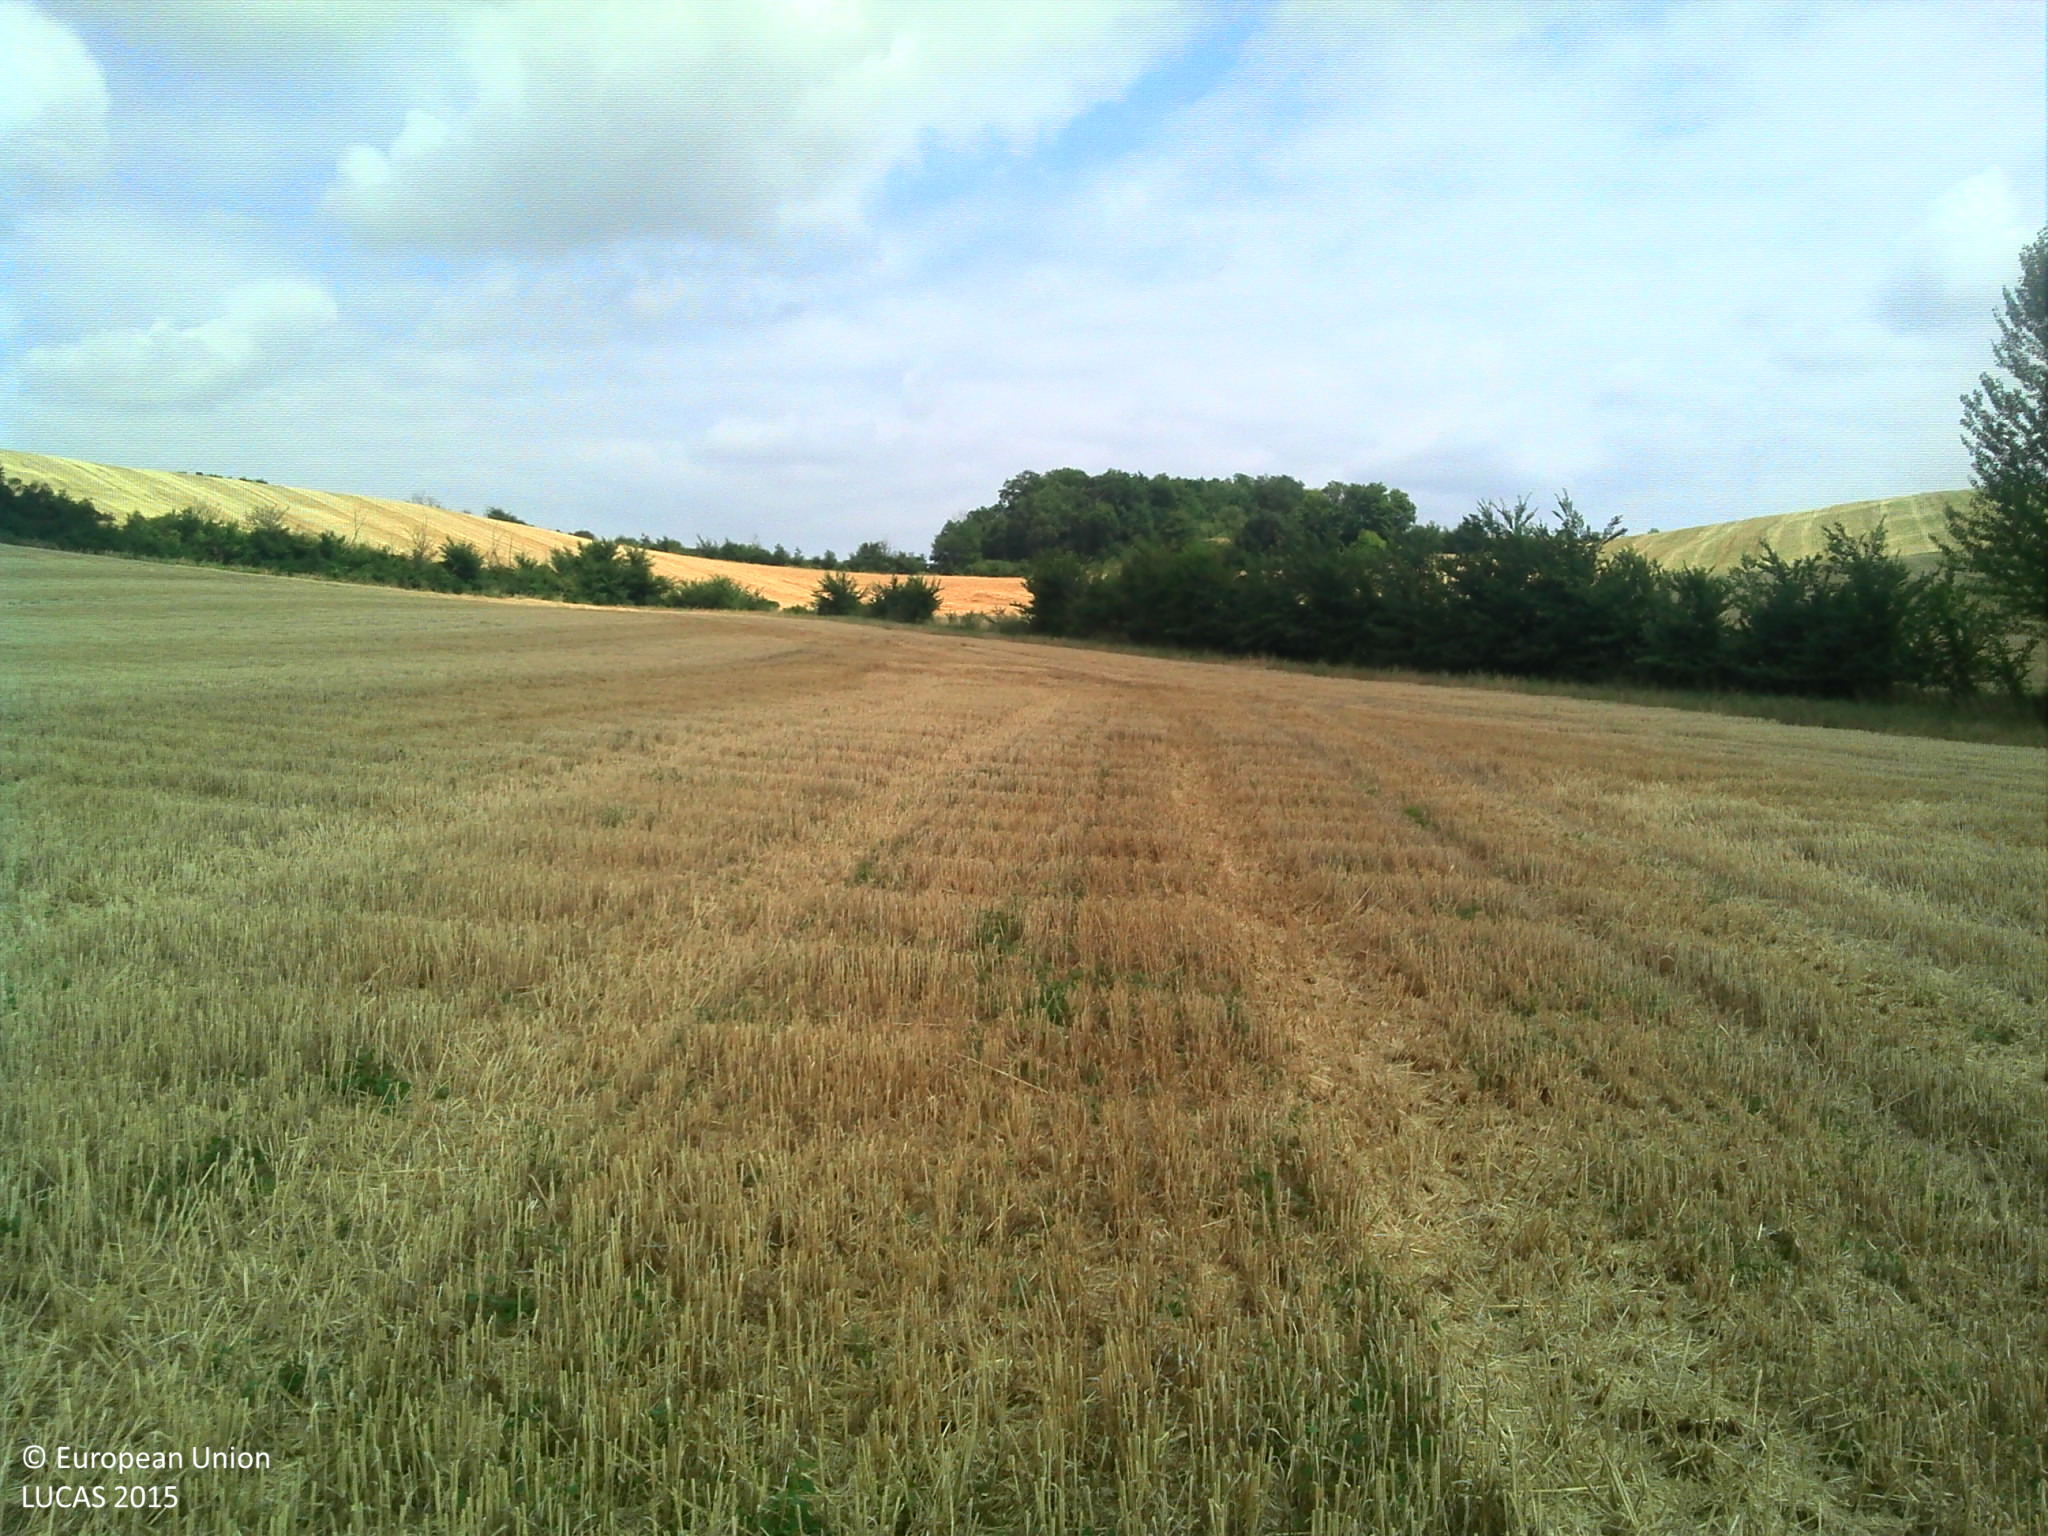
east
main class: Cropland
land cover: Barley
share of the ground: > 75 %
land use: Agriculture (excluding fallow land and kitchen gardens)
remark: Harvested field
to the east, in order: Barley; Grass margins; Ditches and canals; Managed hedges; Barley
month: July
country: FR
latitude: 43.8103
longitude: 0.9614
